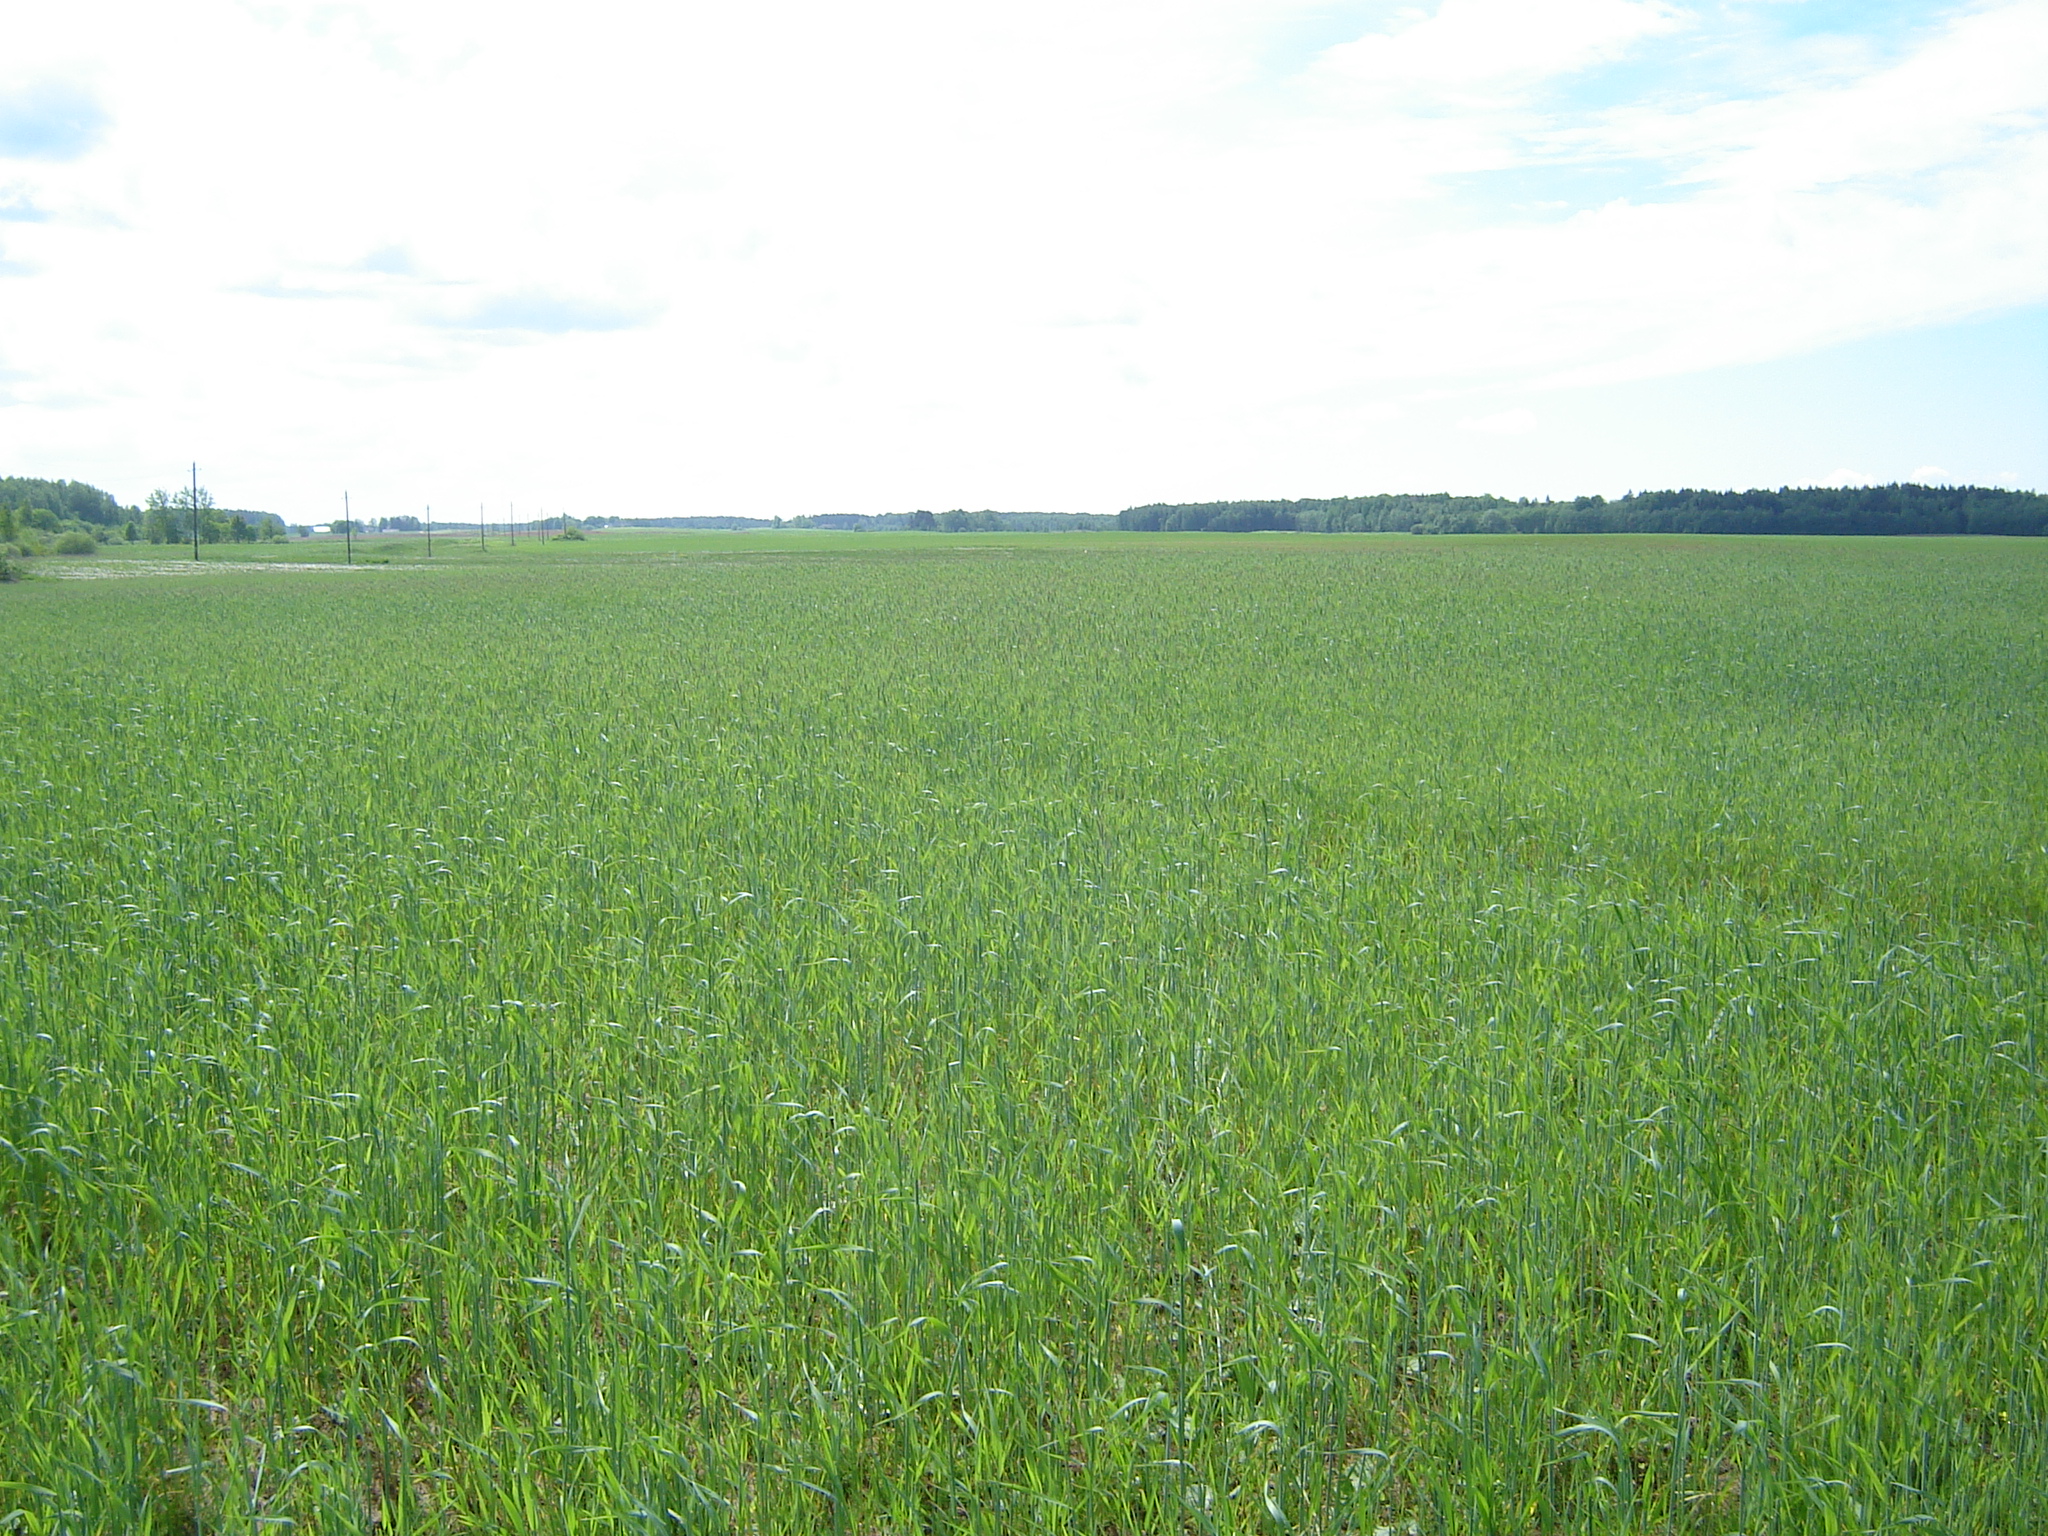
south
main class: Cropland
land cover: Rye
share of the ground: > 75 %
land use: Agriculture (excluding fallow land and kitchen gardens)
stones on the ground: < 10 %
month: May
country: LT
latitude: 55.7933
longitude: 25.1550
